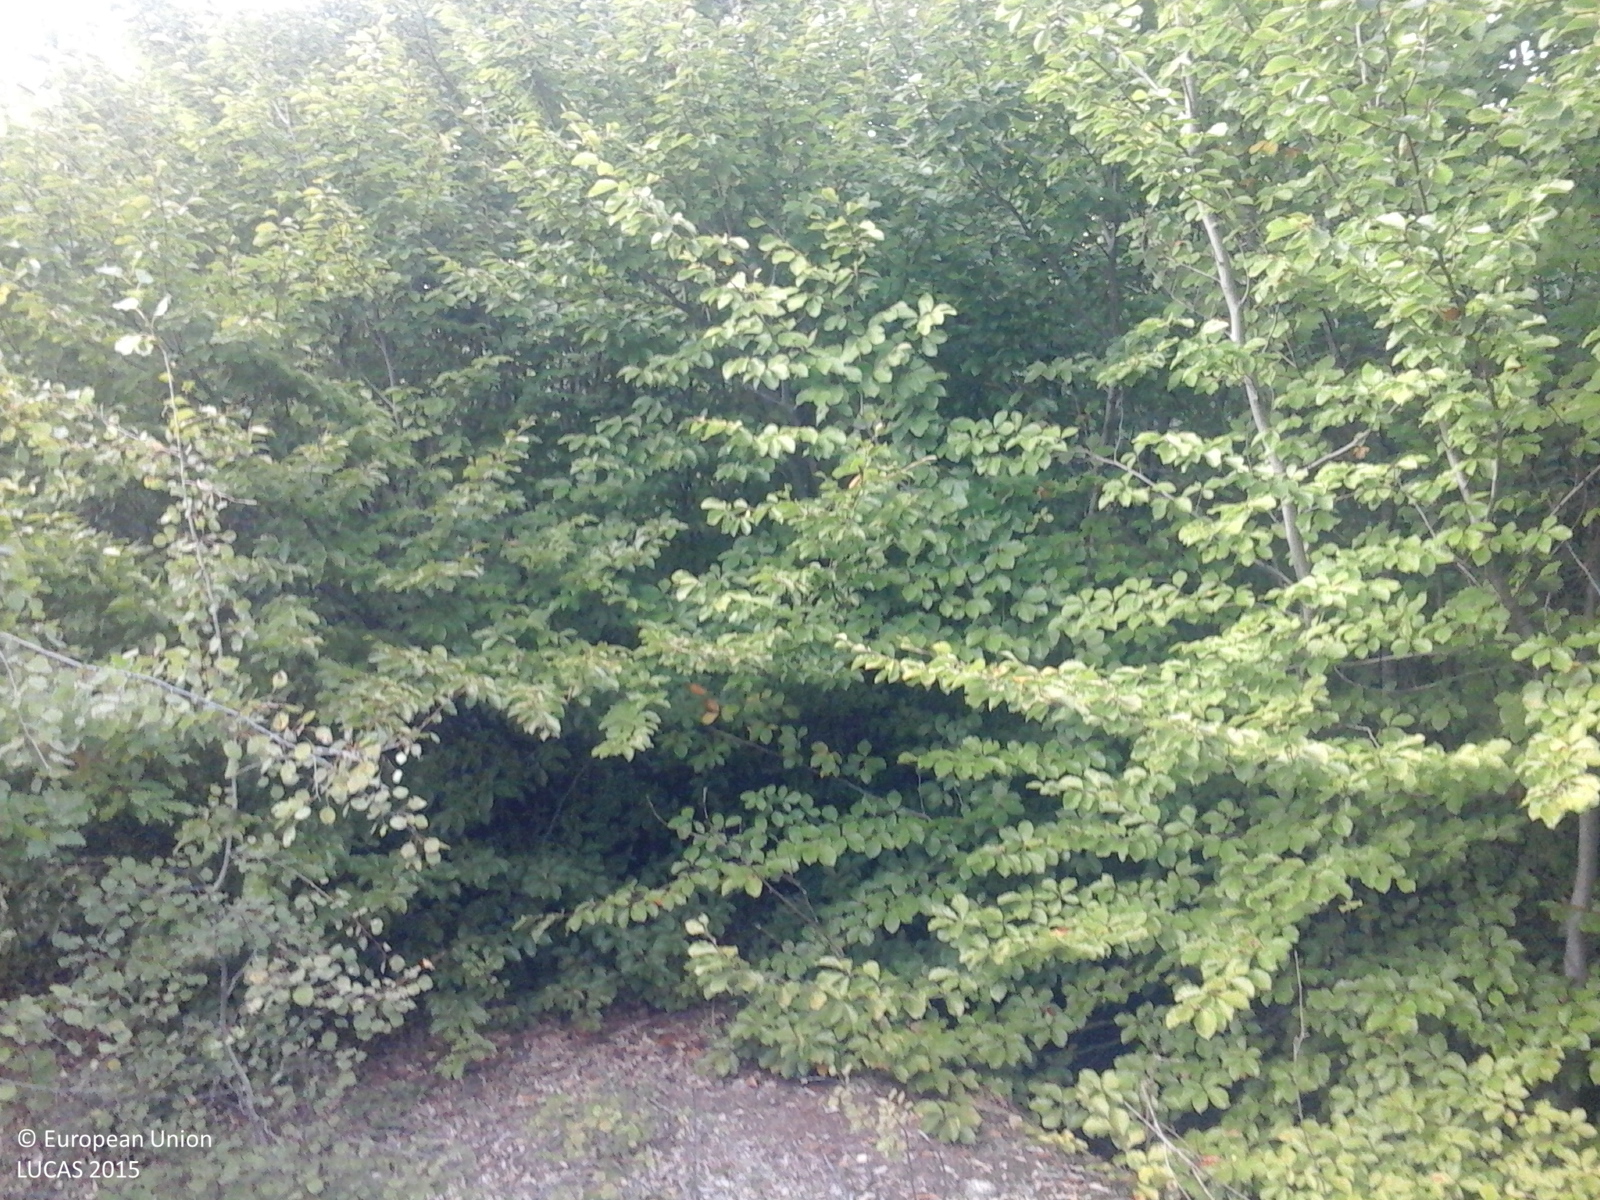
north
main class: Woodland
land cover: Broadleaved woodland
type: mesophytic deciduous forest
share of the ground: > 75 %
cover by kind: broadleaved forest trees 100 %
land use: Forestry
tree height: > 5 m
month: September
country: RO
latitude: 45.0566
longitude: 23.6087
